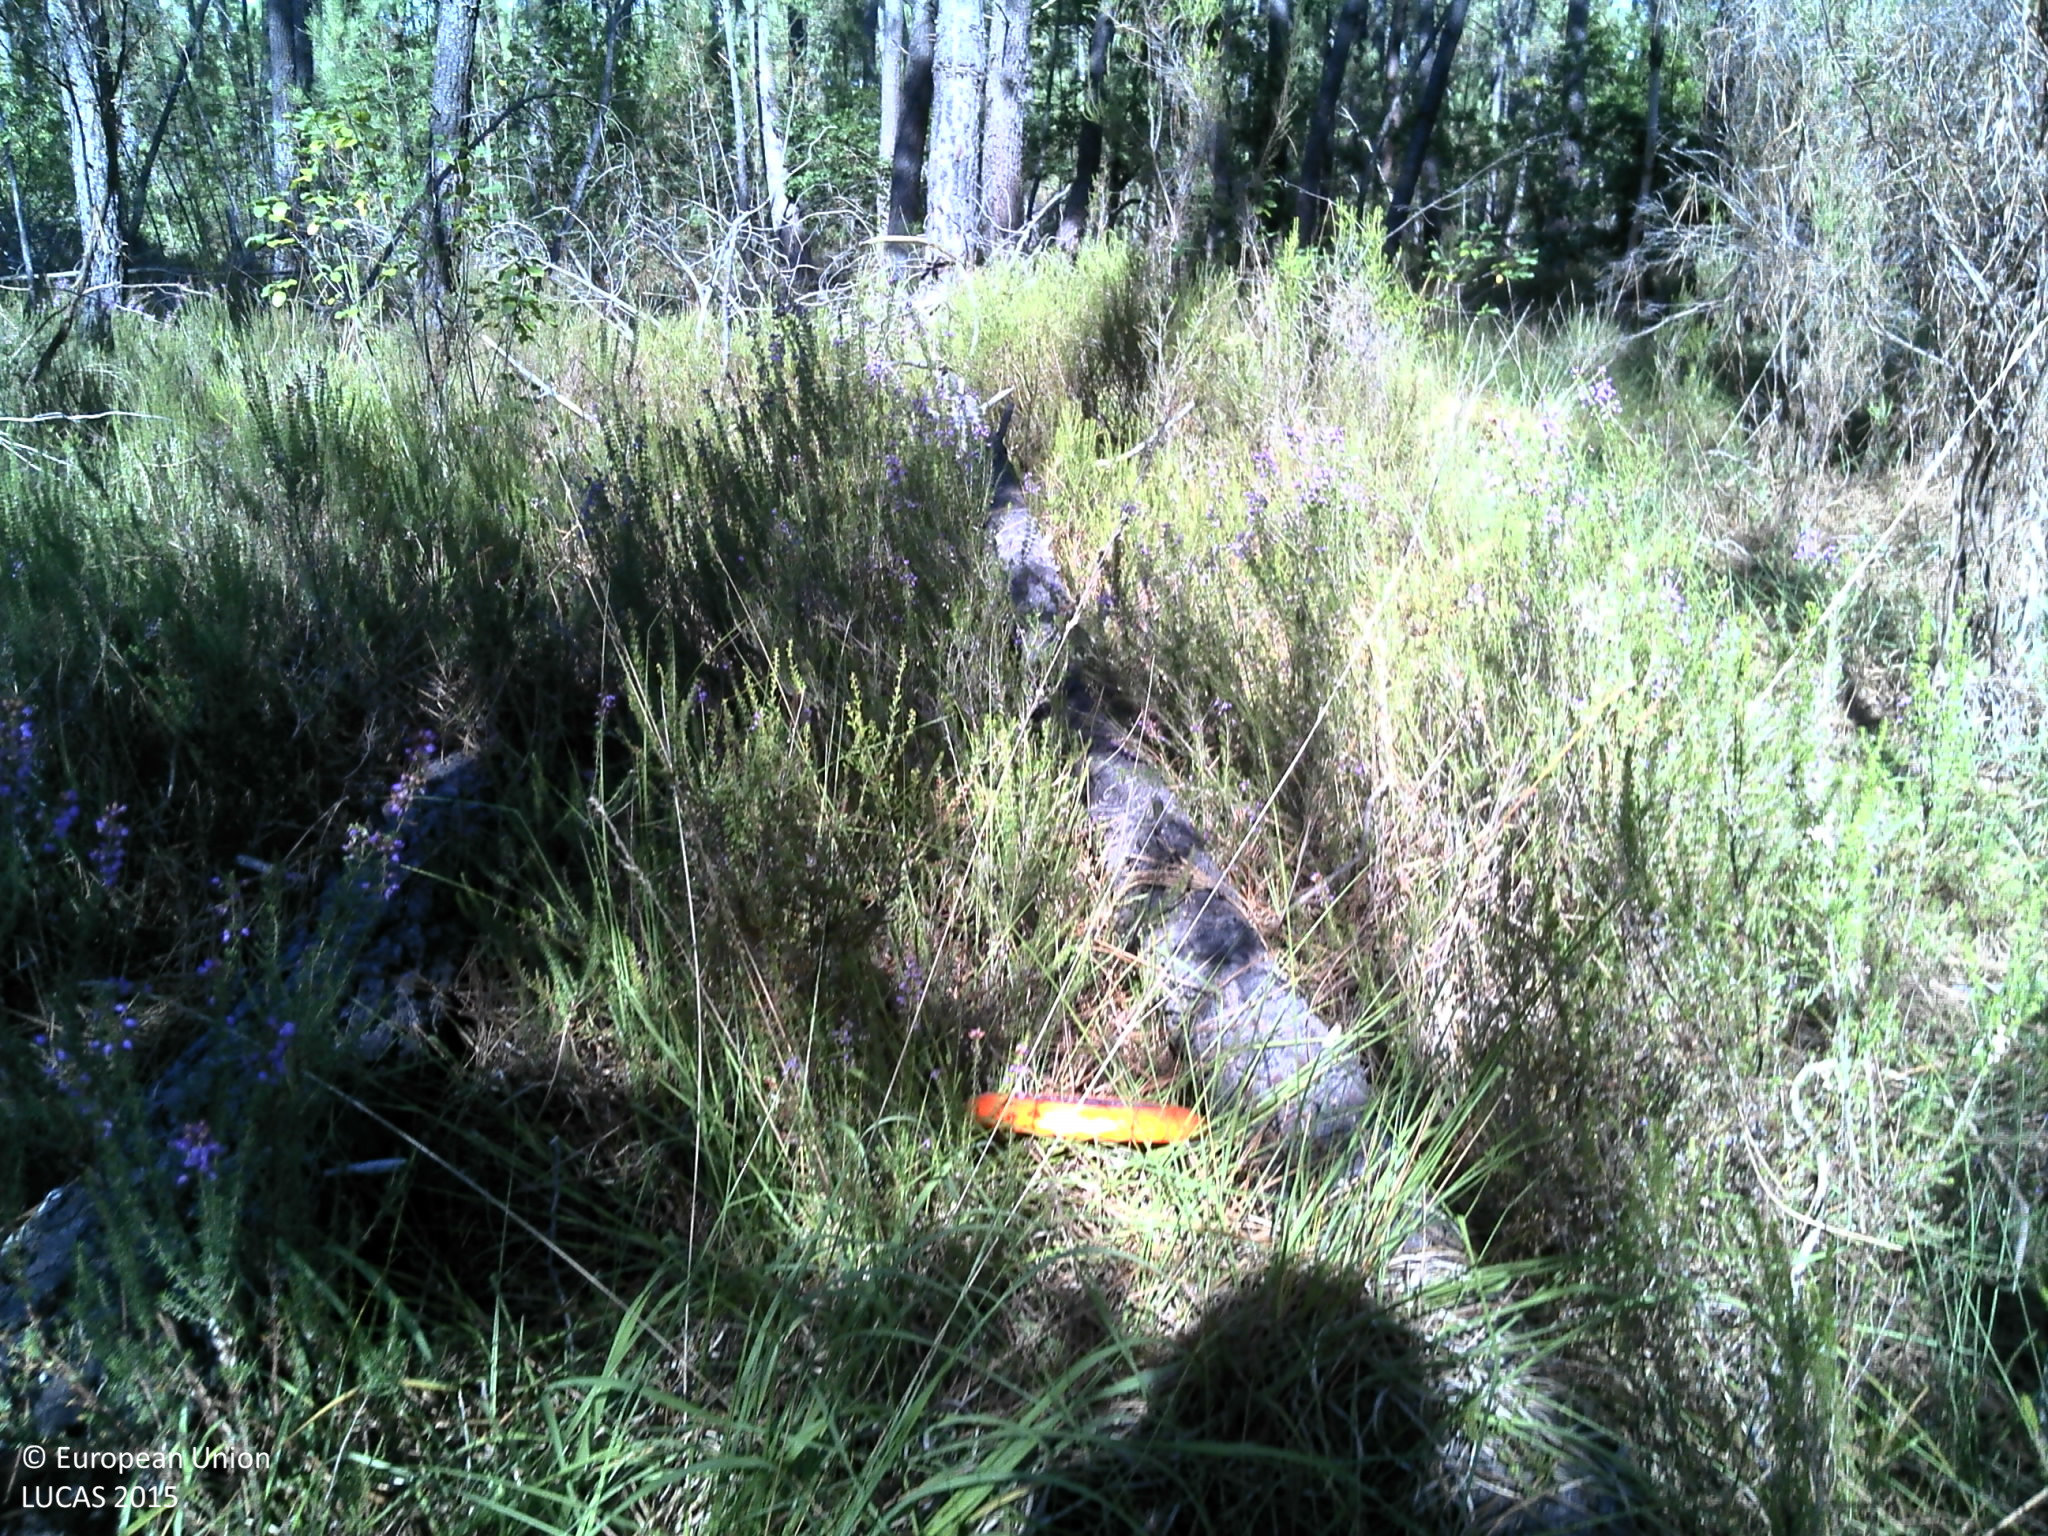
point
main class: Woodland
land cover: Pine dominated coniferous woodland
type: coniferous forest of the mediterranean region
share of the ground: > 75 %
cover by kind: coniferous forest trees 60 %, shrubs 30 %, herbaceous plants 5 %, lichens and mosses 5 %
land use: Forestry
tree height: > 5 m
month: July
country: FR
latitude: 44.5408
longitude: -0.5254
